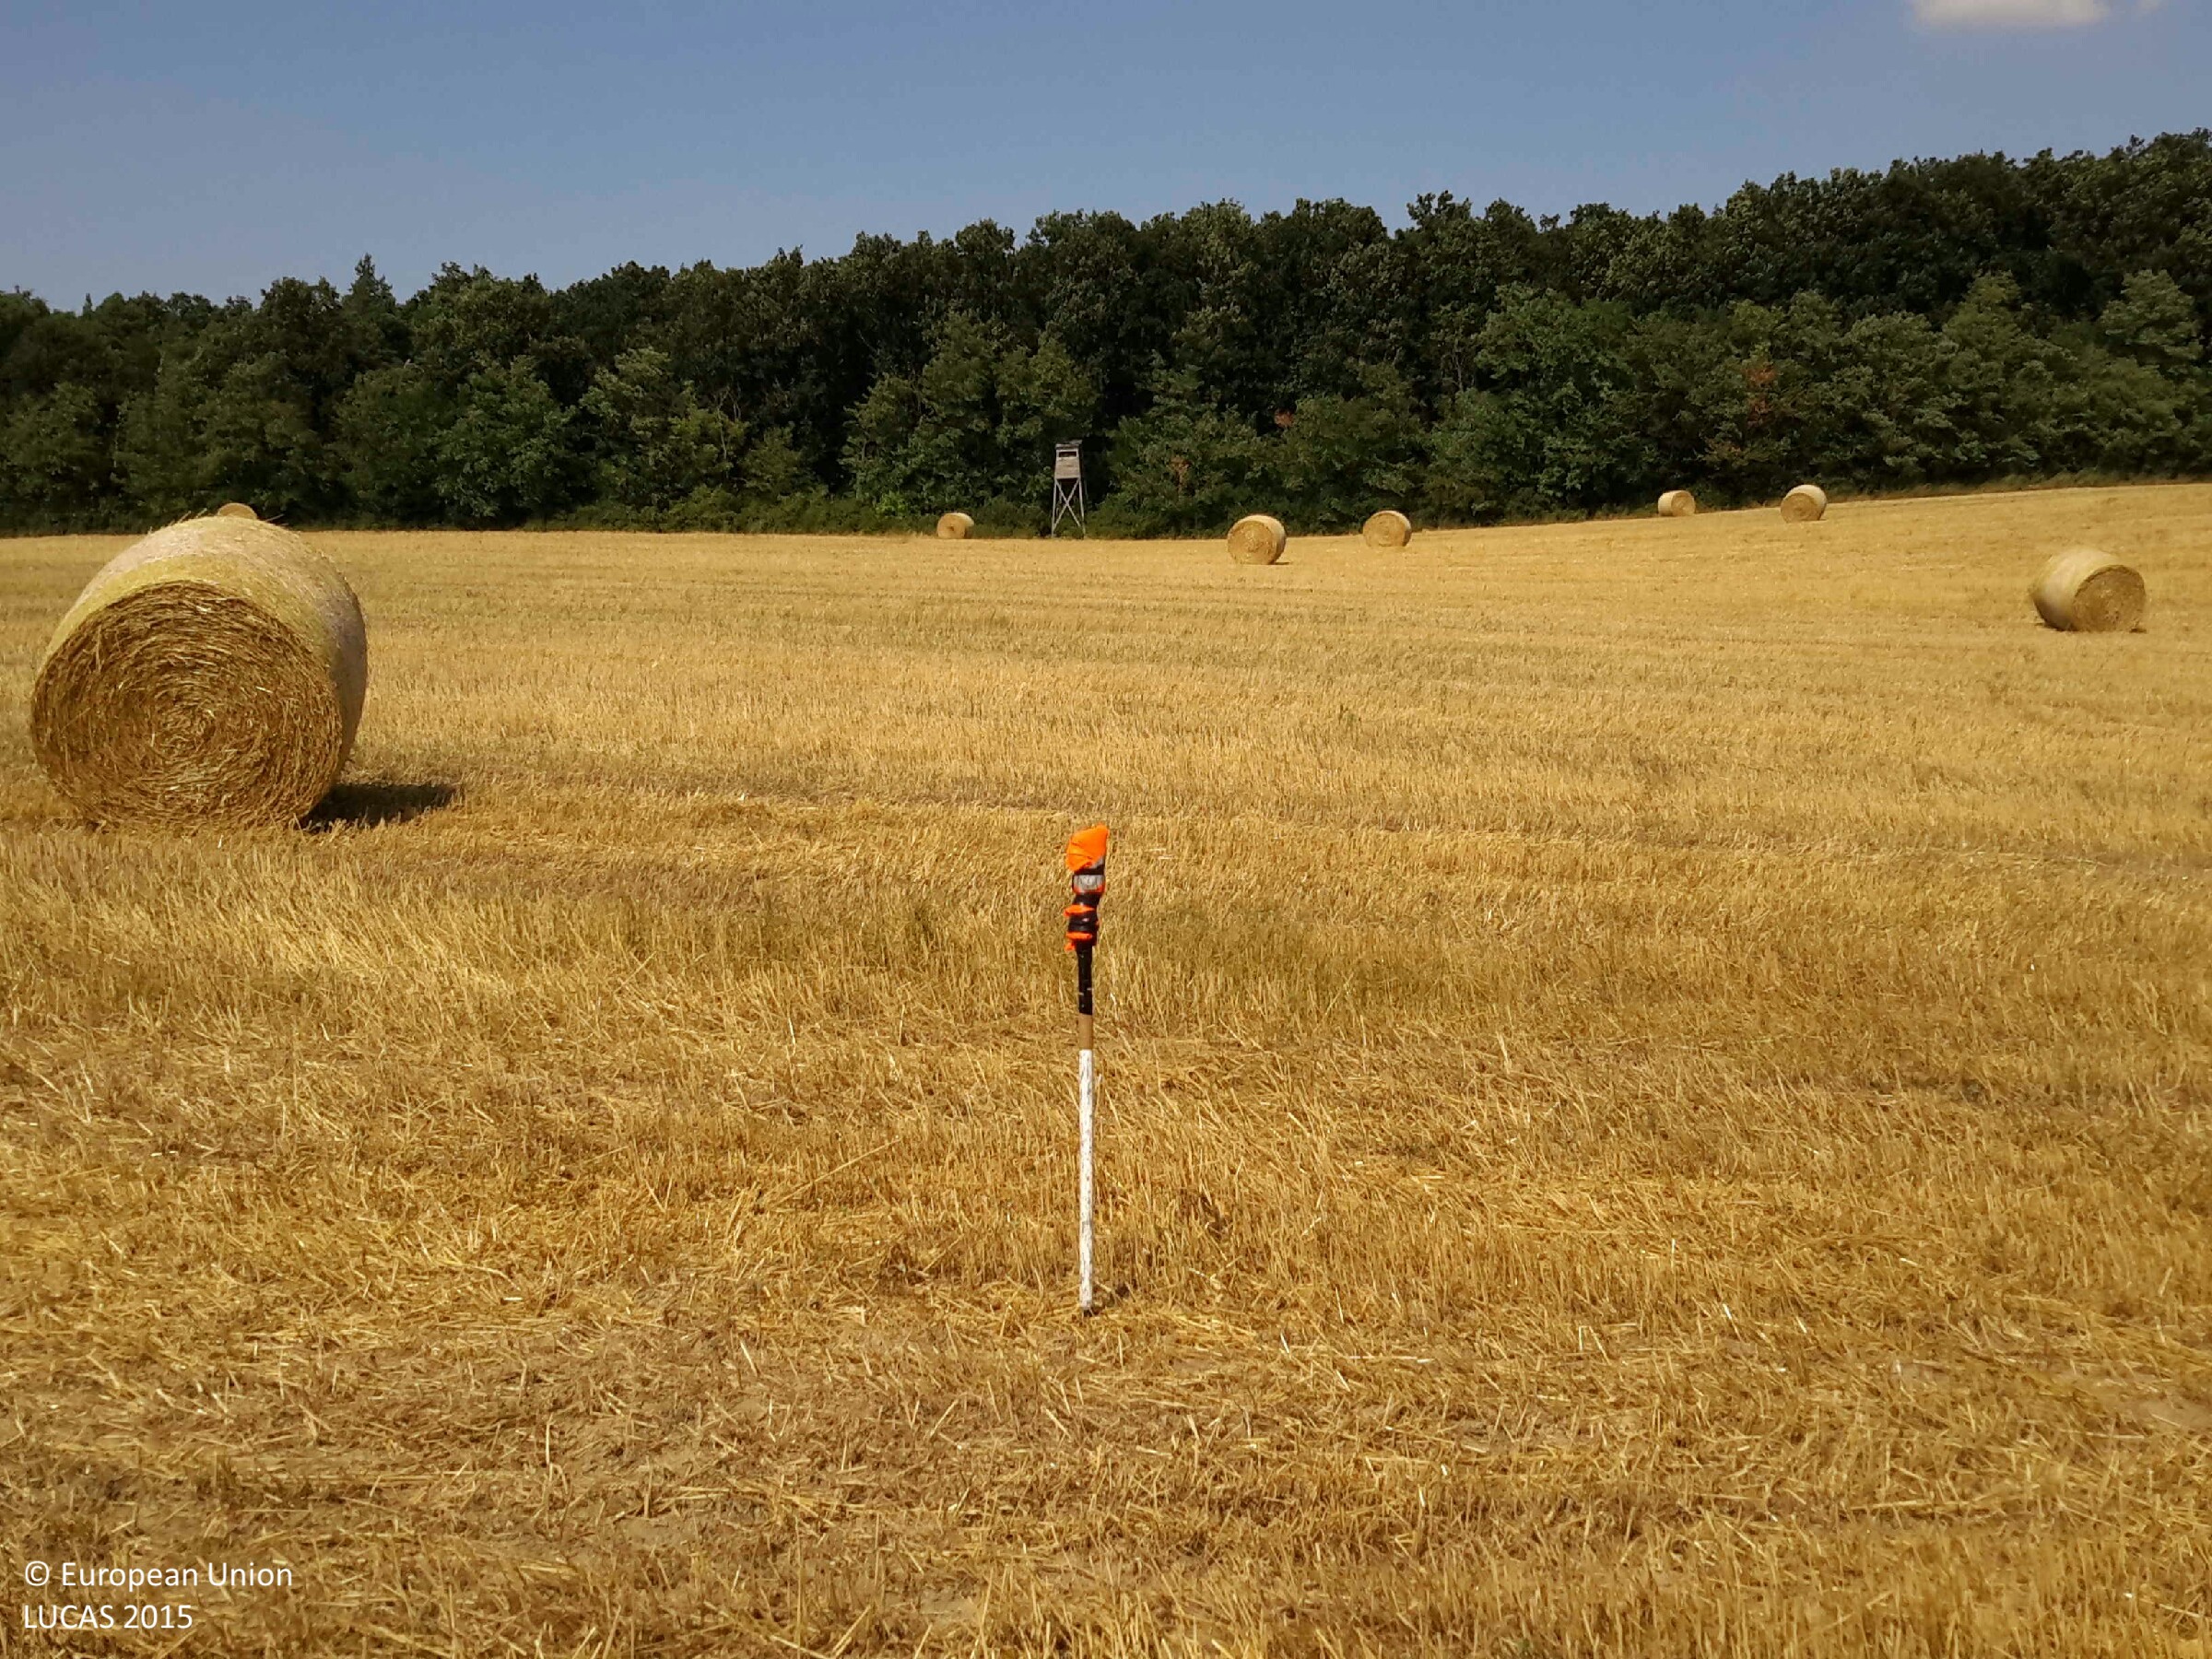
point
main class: Cropland
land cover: Common wheat
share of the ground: 50 - 75 %
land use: Agriculture (excluding fallow land and kitchen gardens)
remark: Harvested field
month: July
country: HU
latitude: 47.5146
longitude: 17.7777
